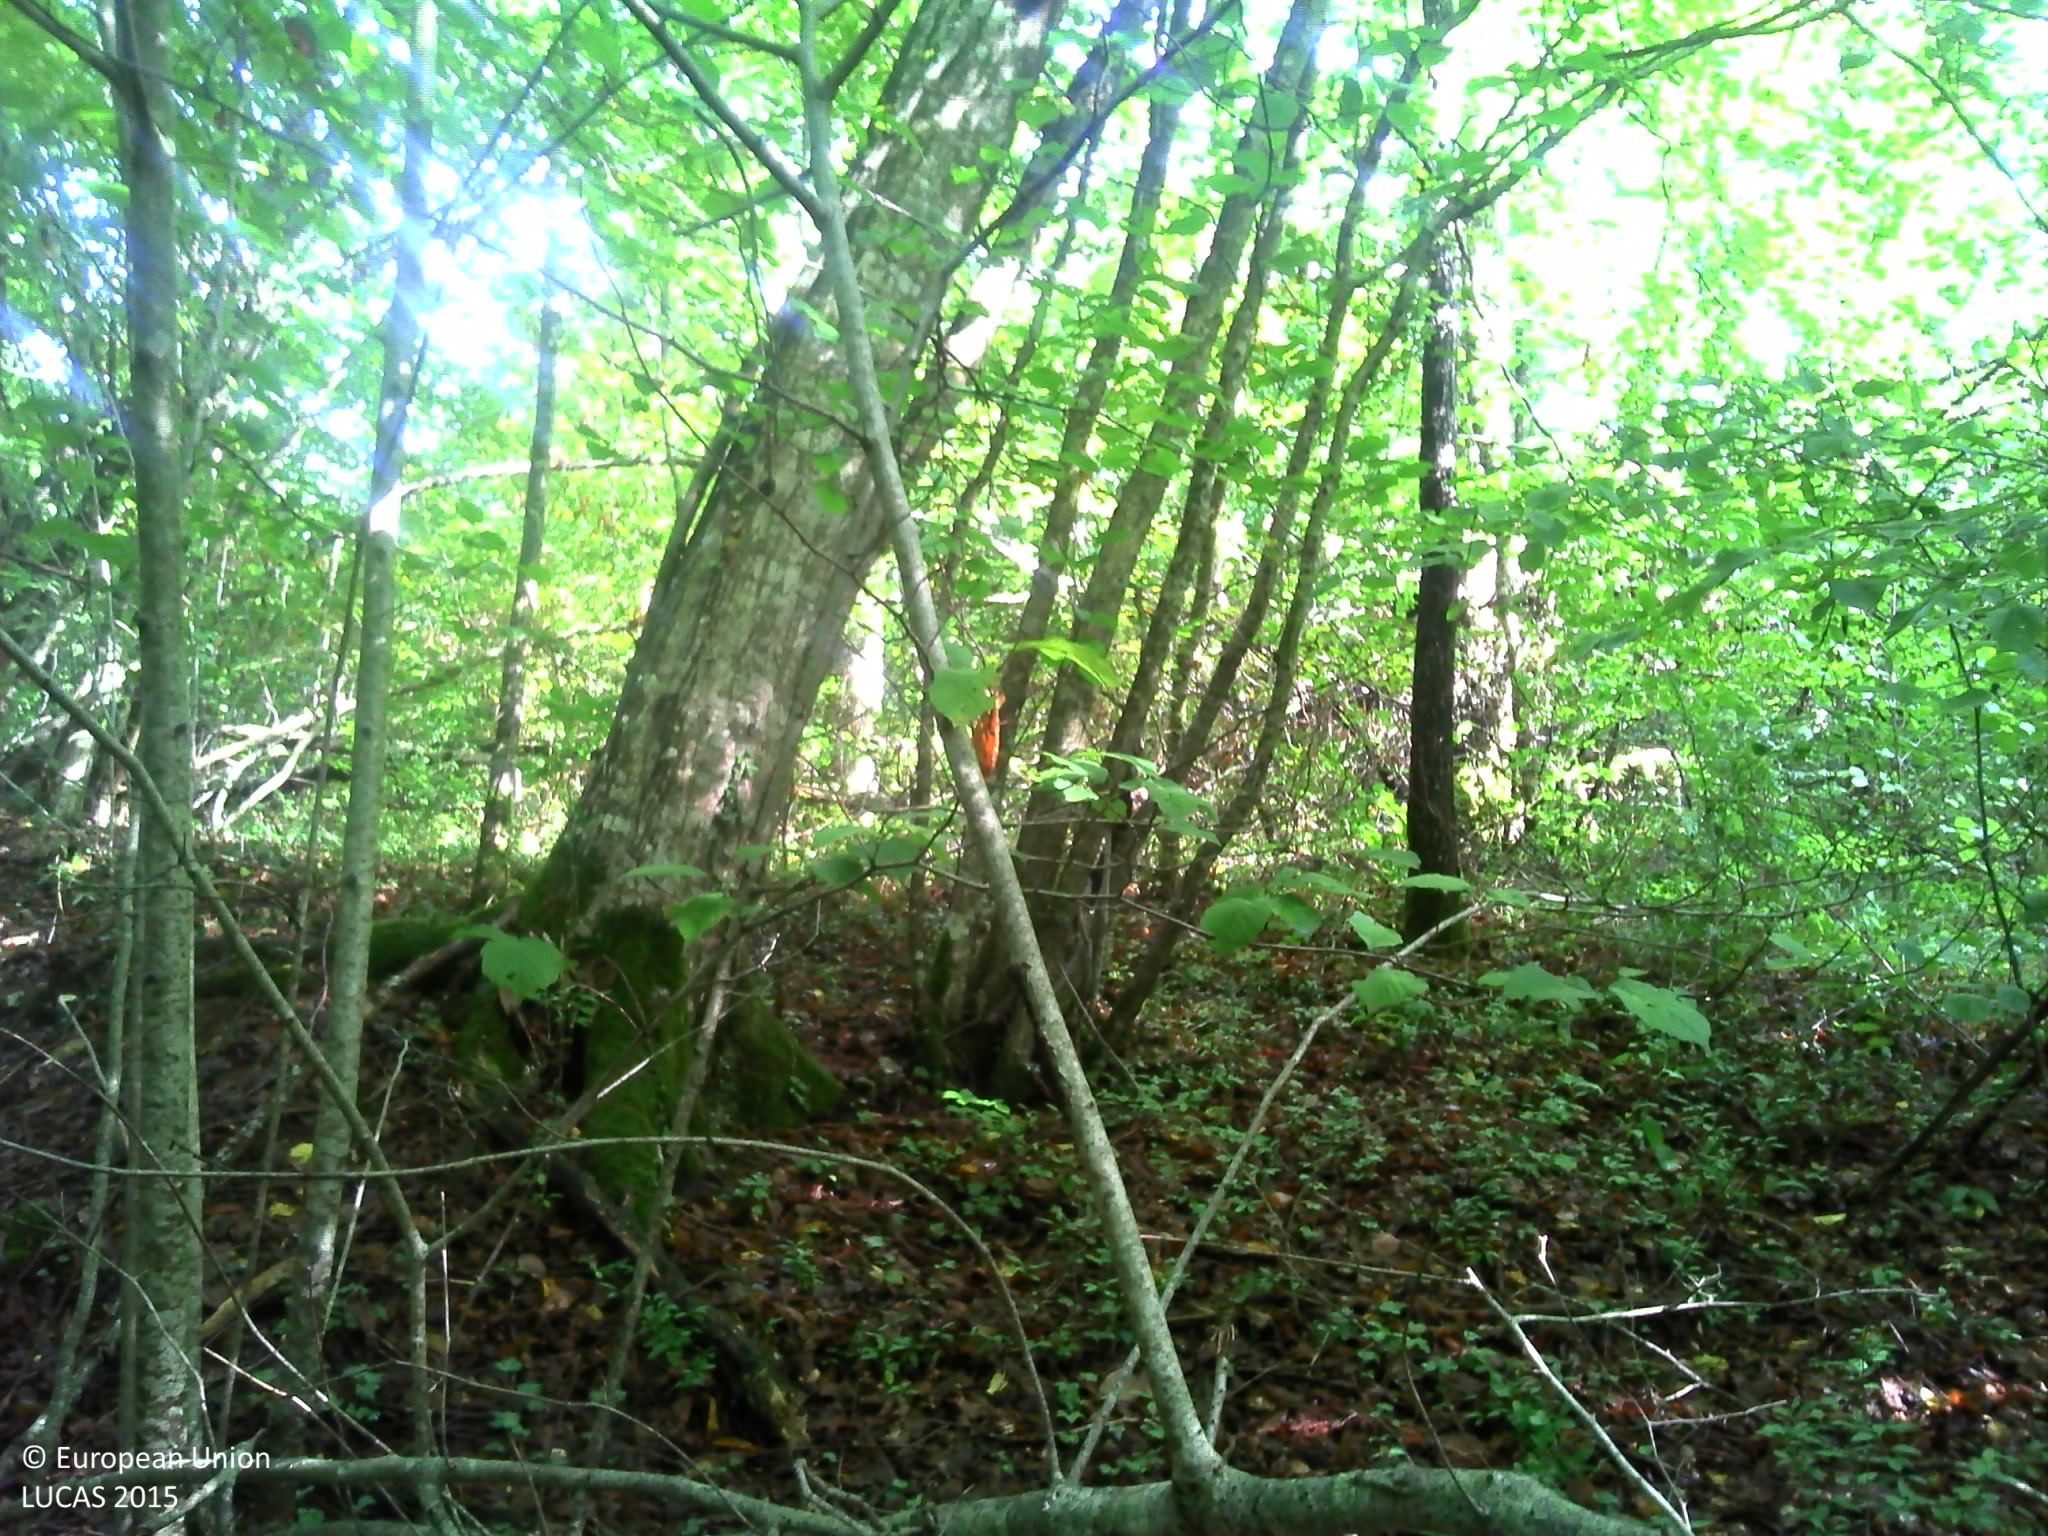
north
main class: Woodland
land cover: Broadleaved woodland
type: mesophytic deciduous forest
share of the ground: > 75 %
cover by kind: broadleaved forest trees 90 %, herbaceous plants 5 %, consolidated bare surface 5 %
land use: Forestry
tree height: > 5 m
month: September
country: FR
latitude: 48.8349
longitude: 5.9807
